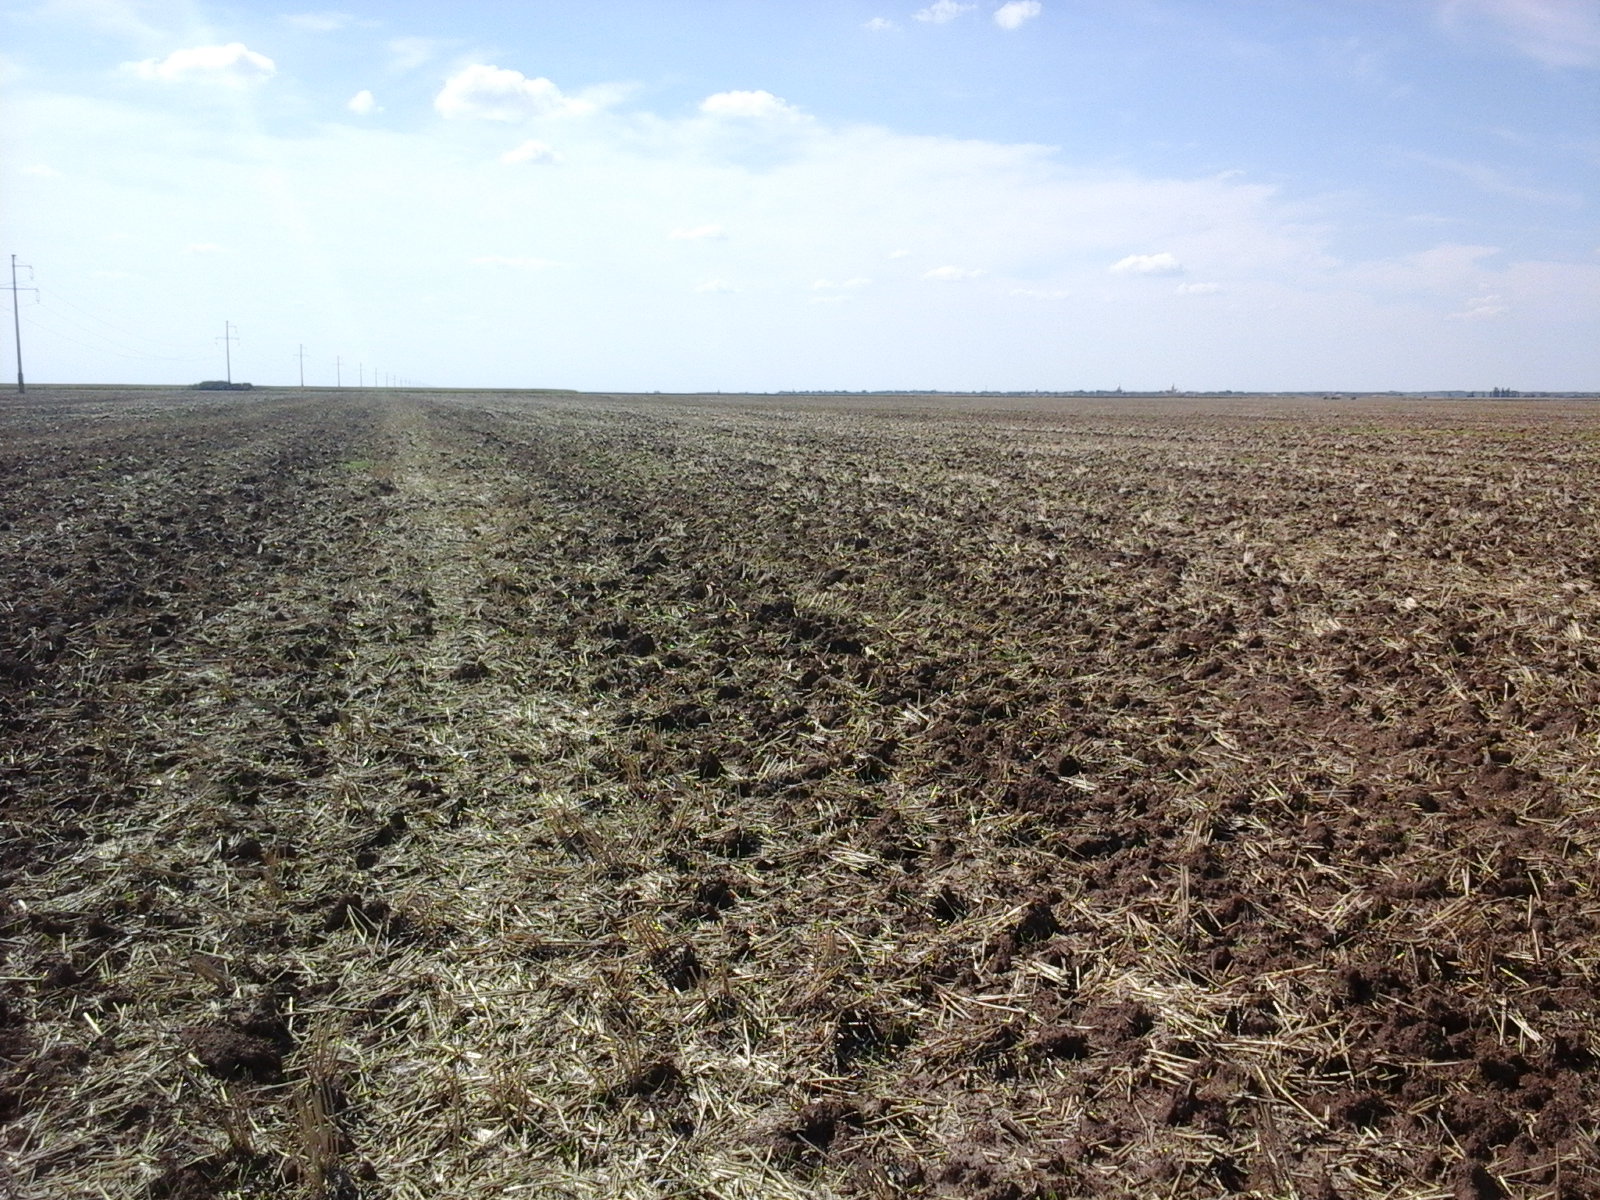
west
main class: Cropland
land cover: Common wheat
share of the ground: < 10 %
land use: Agriculture (excluding fallow land and kitchen gardens)
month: October
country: RO
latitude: 46.1067
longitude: 21.1970
